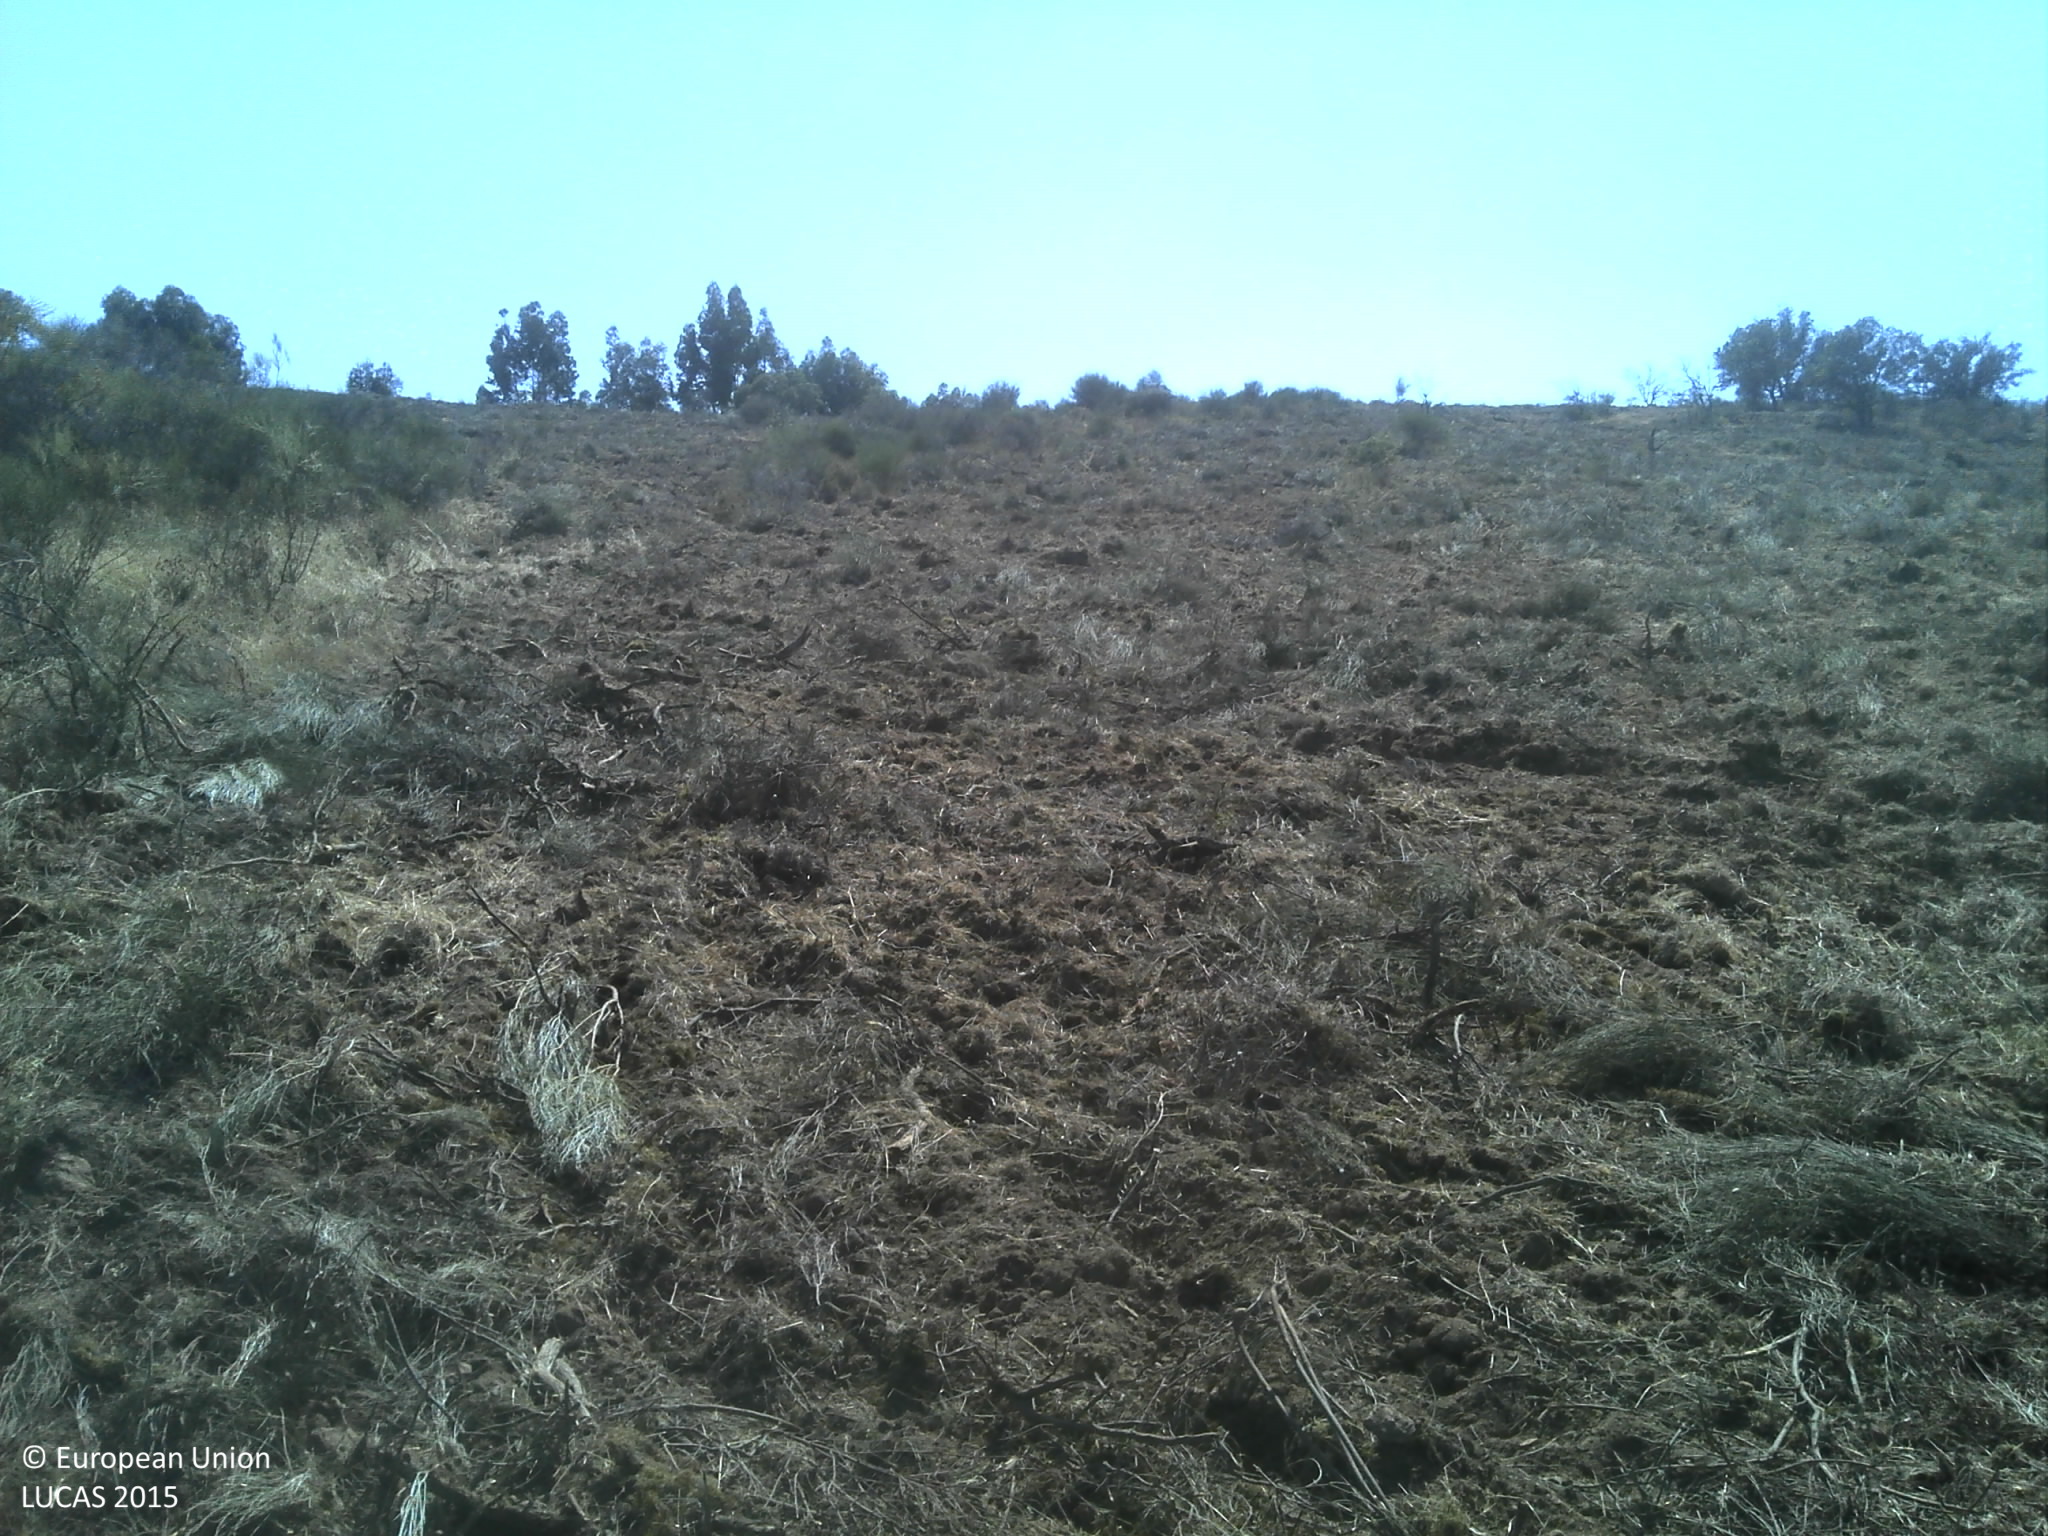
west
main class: Shrubland
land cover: Shrubland without tree cover
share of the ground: > 75 %
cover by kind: shrubs 75 %, herbaceous plants 20 %, unconsolidated bare surface 5 %
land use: Abandoned areas
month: June
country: PT
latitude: 39.7250
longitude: -7.1337
